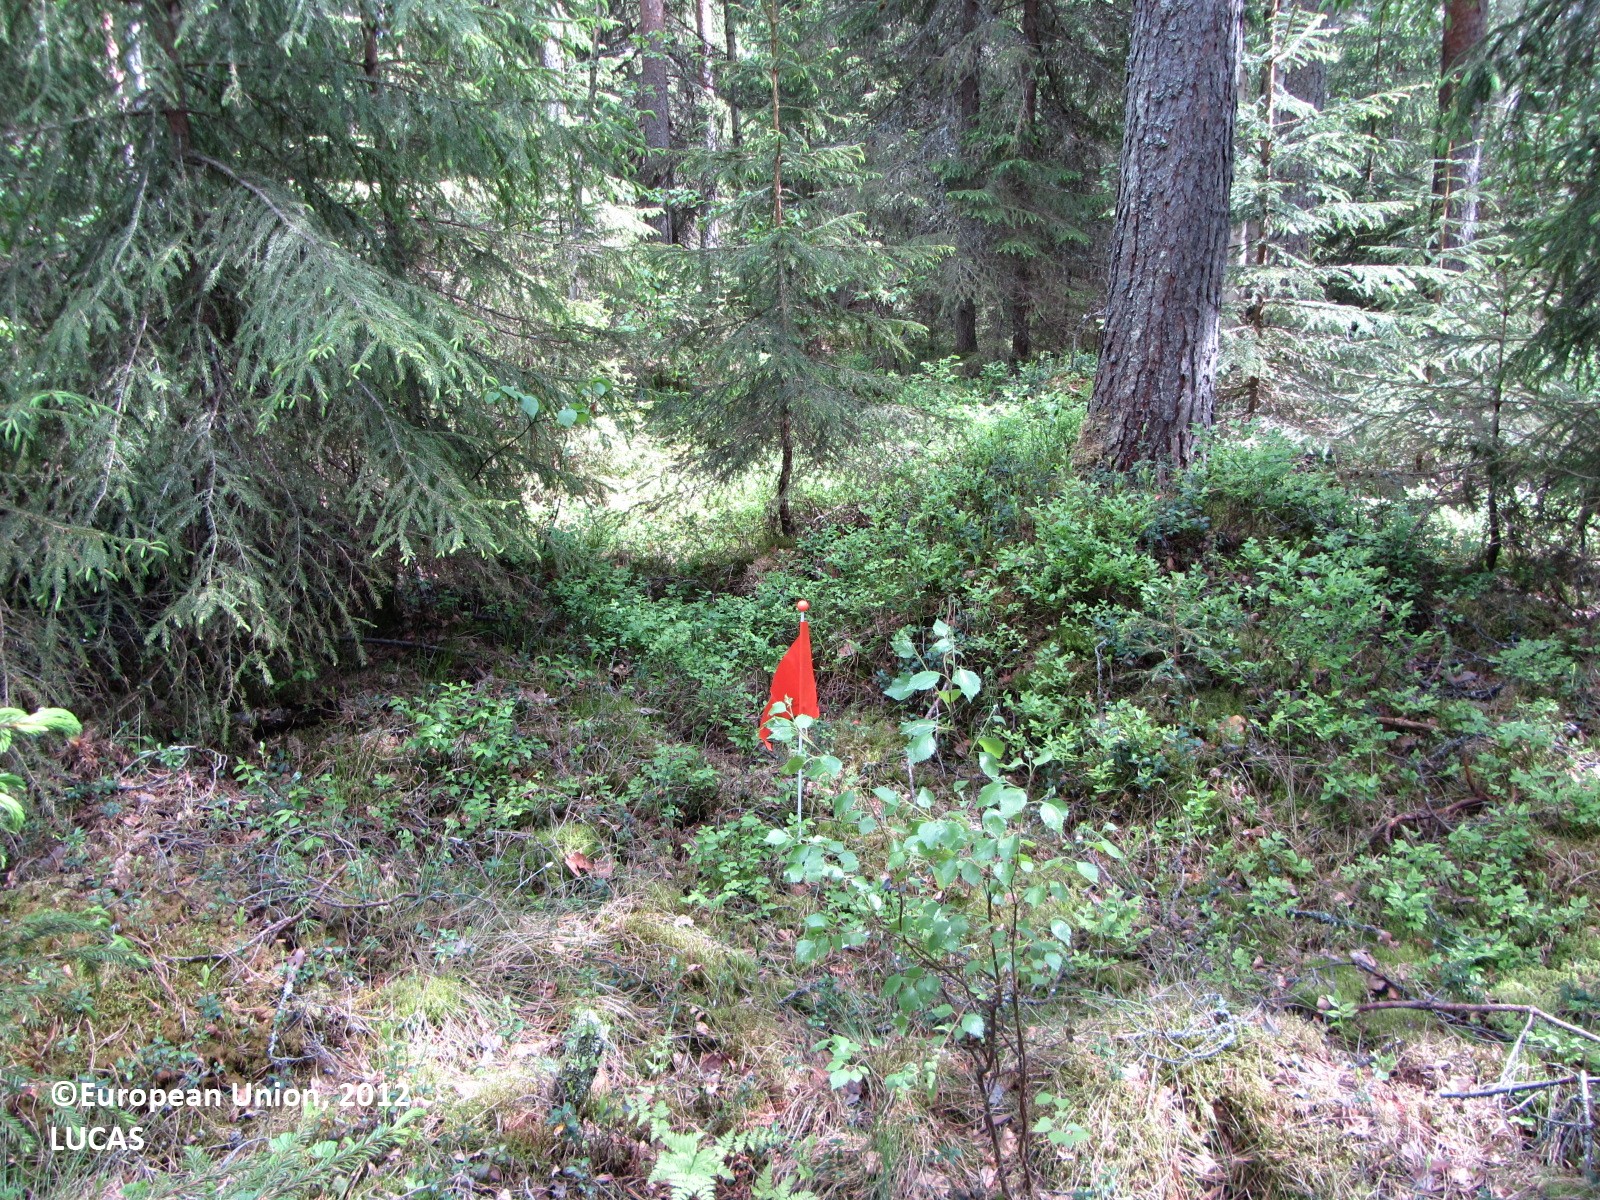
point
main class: Woodland
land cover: Other coniferous woodland
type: boreal forest
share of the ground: > 75 %
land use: Forestry
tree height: > 5 m
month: June
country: FI
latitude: 61.9300
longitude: 24.9834
